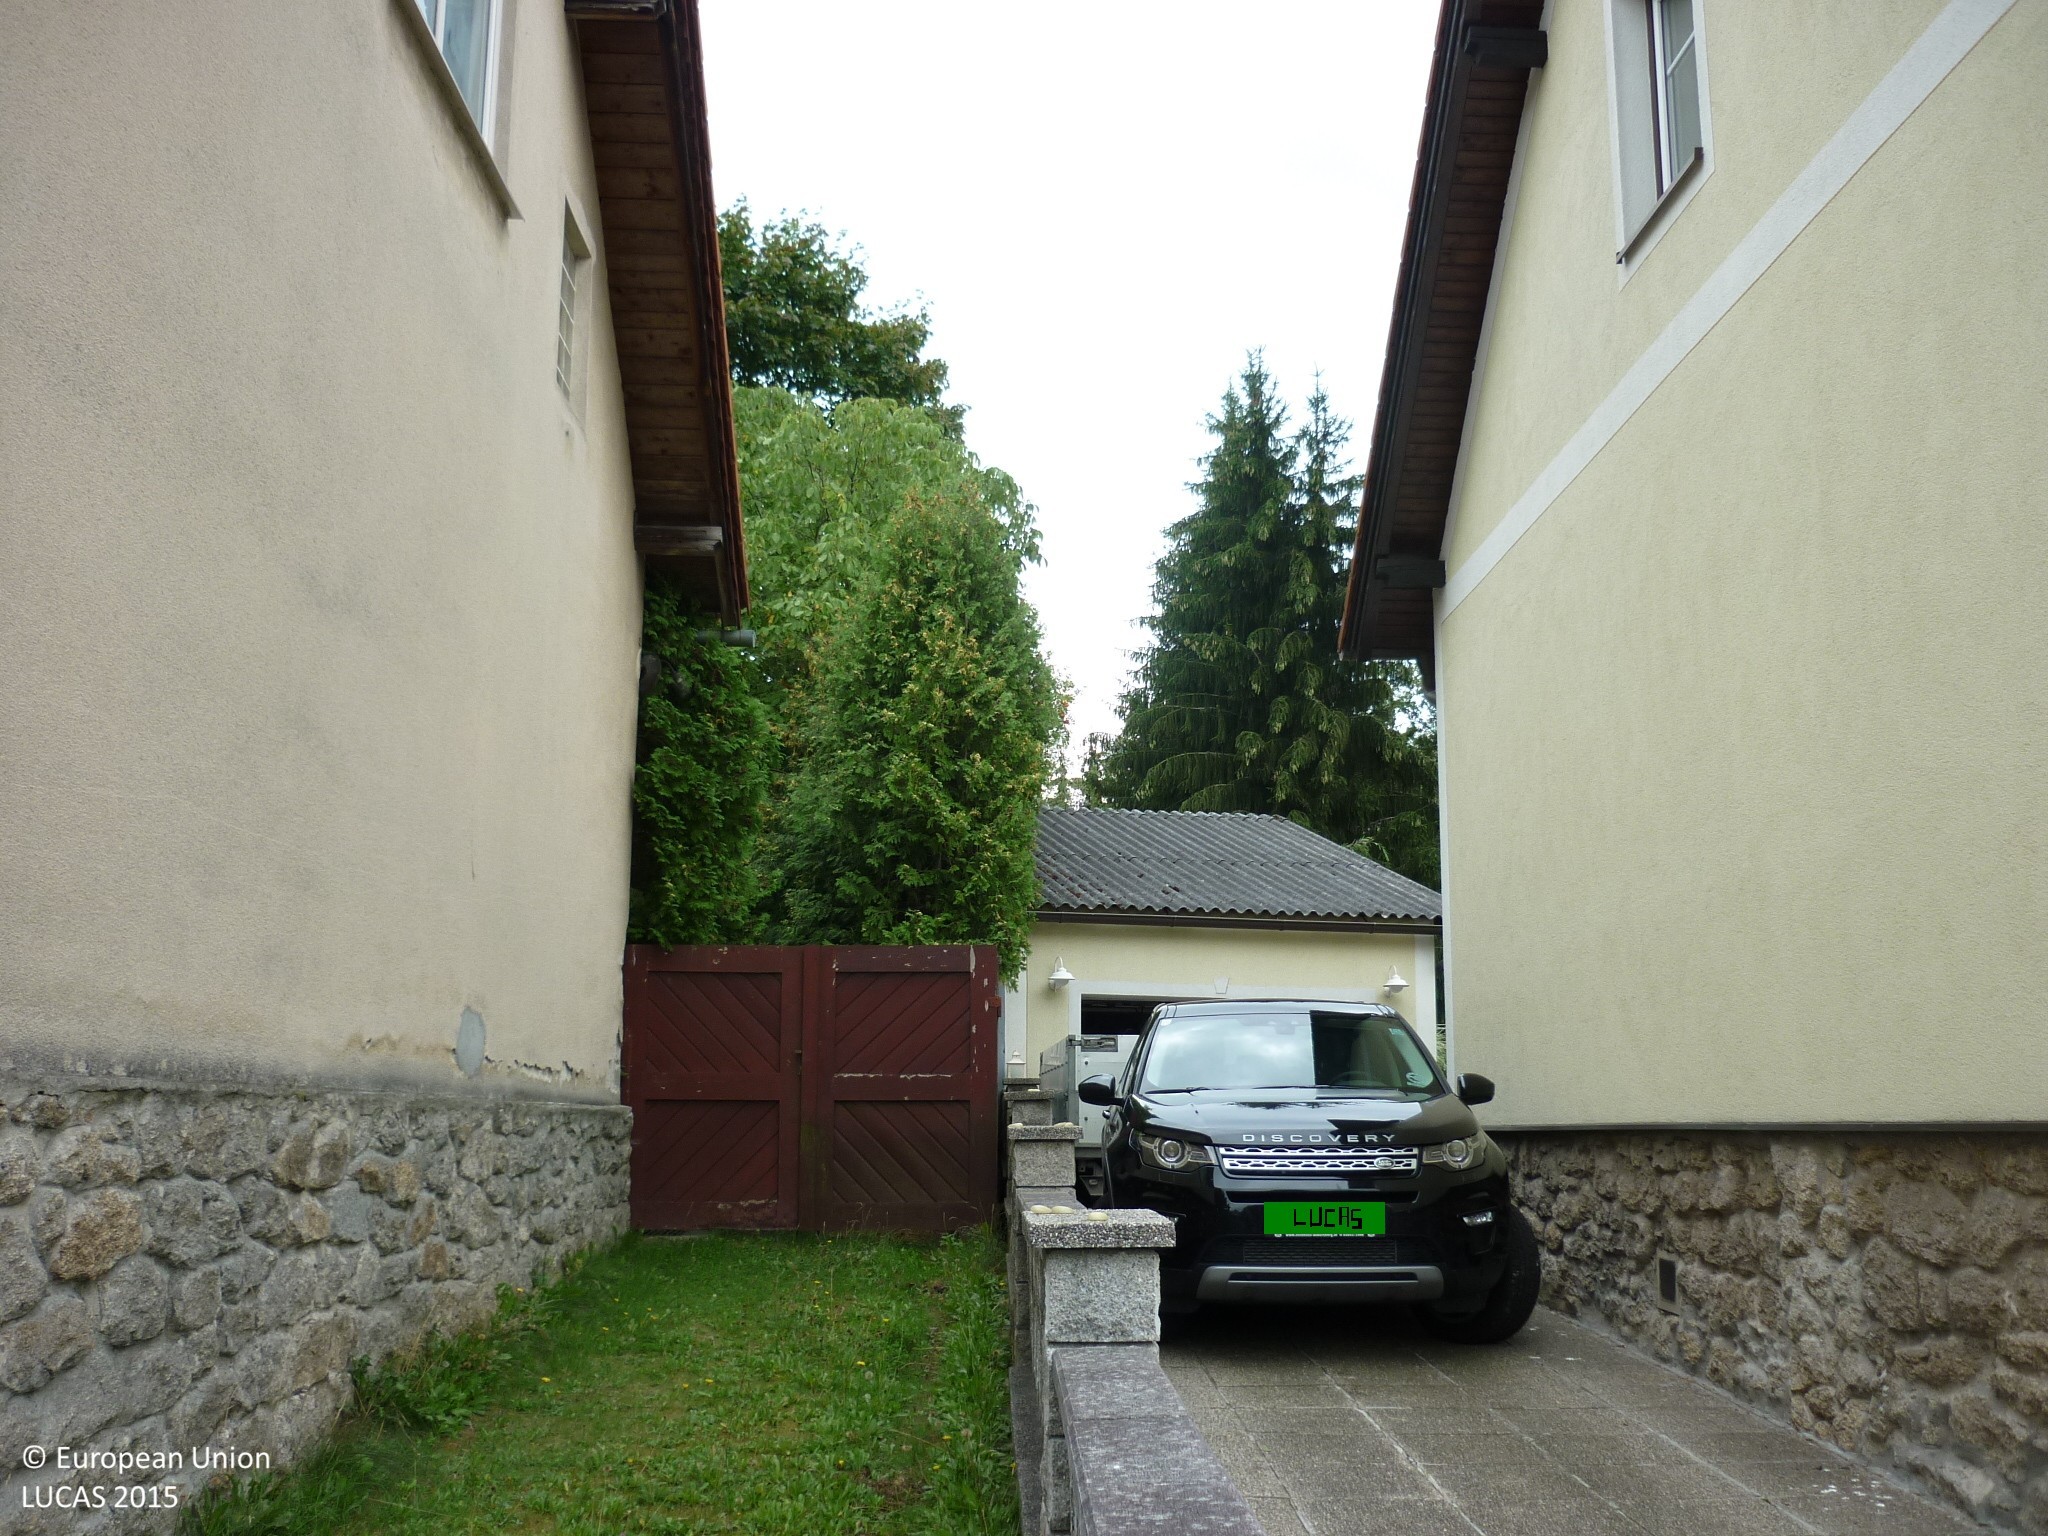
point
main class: Woodland
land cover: Other mixed woodland
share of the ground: > 75 %
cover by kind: coniferous forest trees 50 %, broadleaved forest trees 50 %
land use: Residential
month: September
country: AT
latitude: 48.8621
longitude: 15.1139
